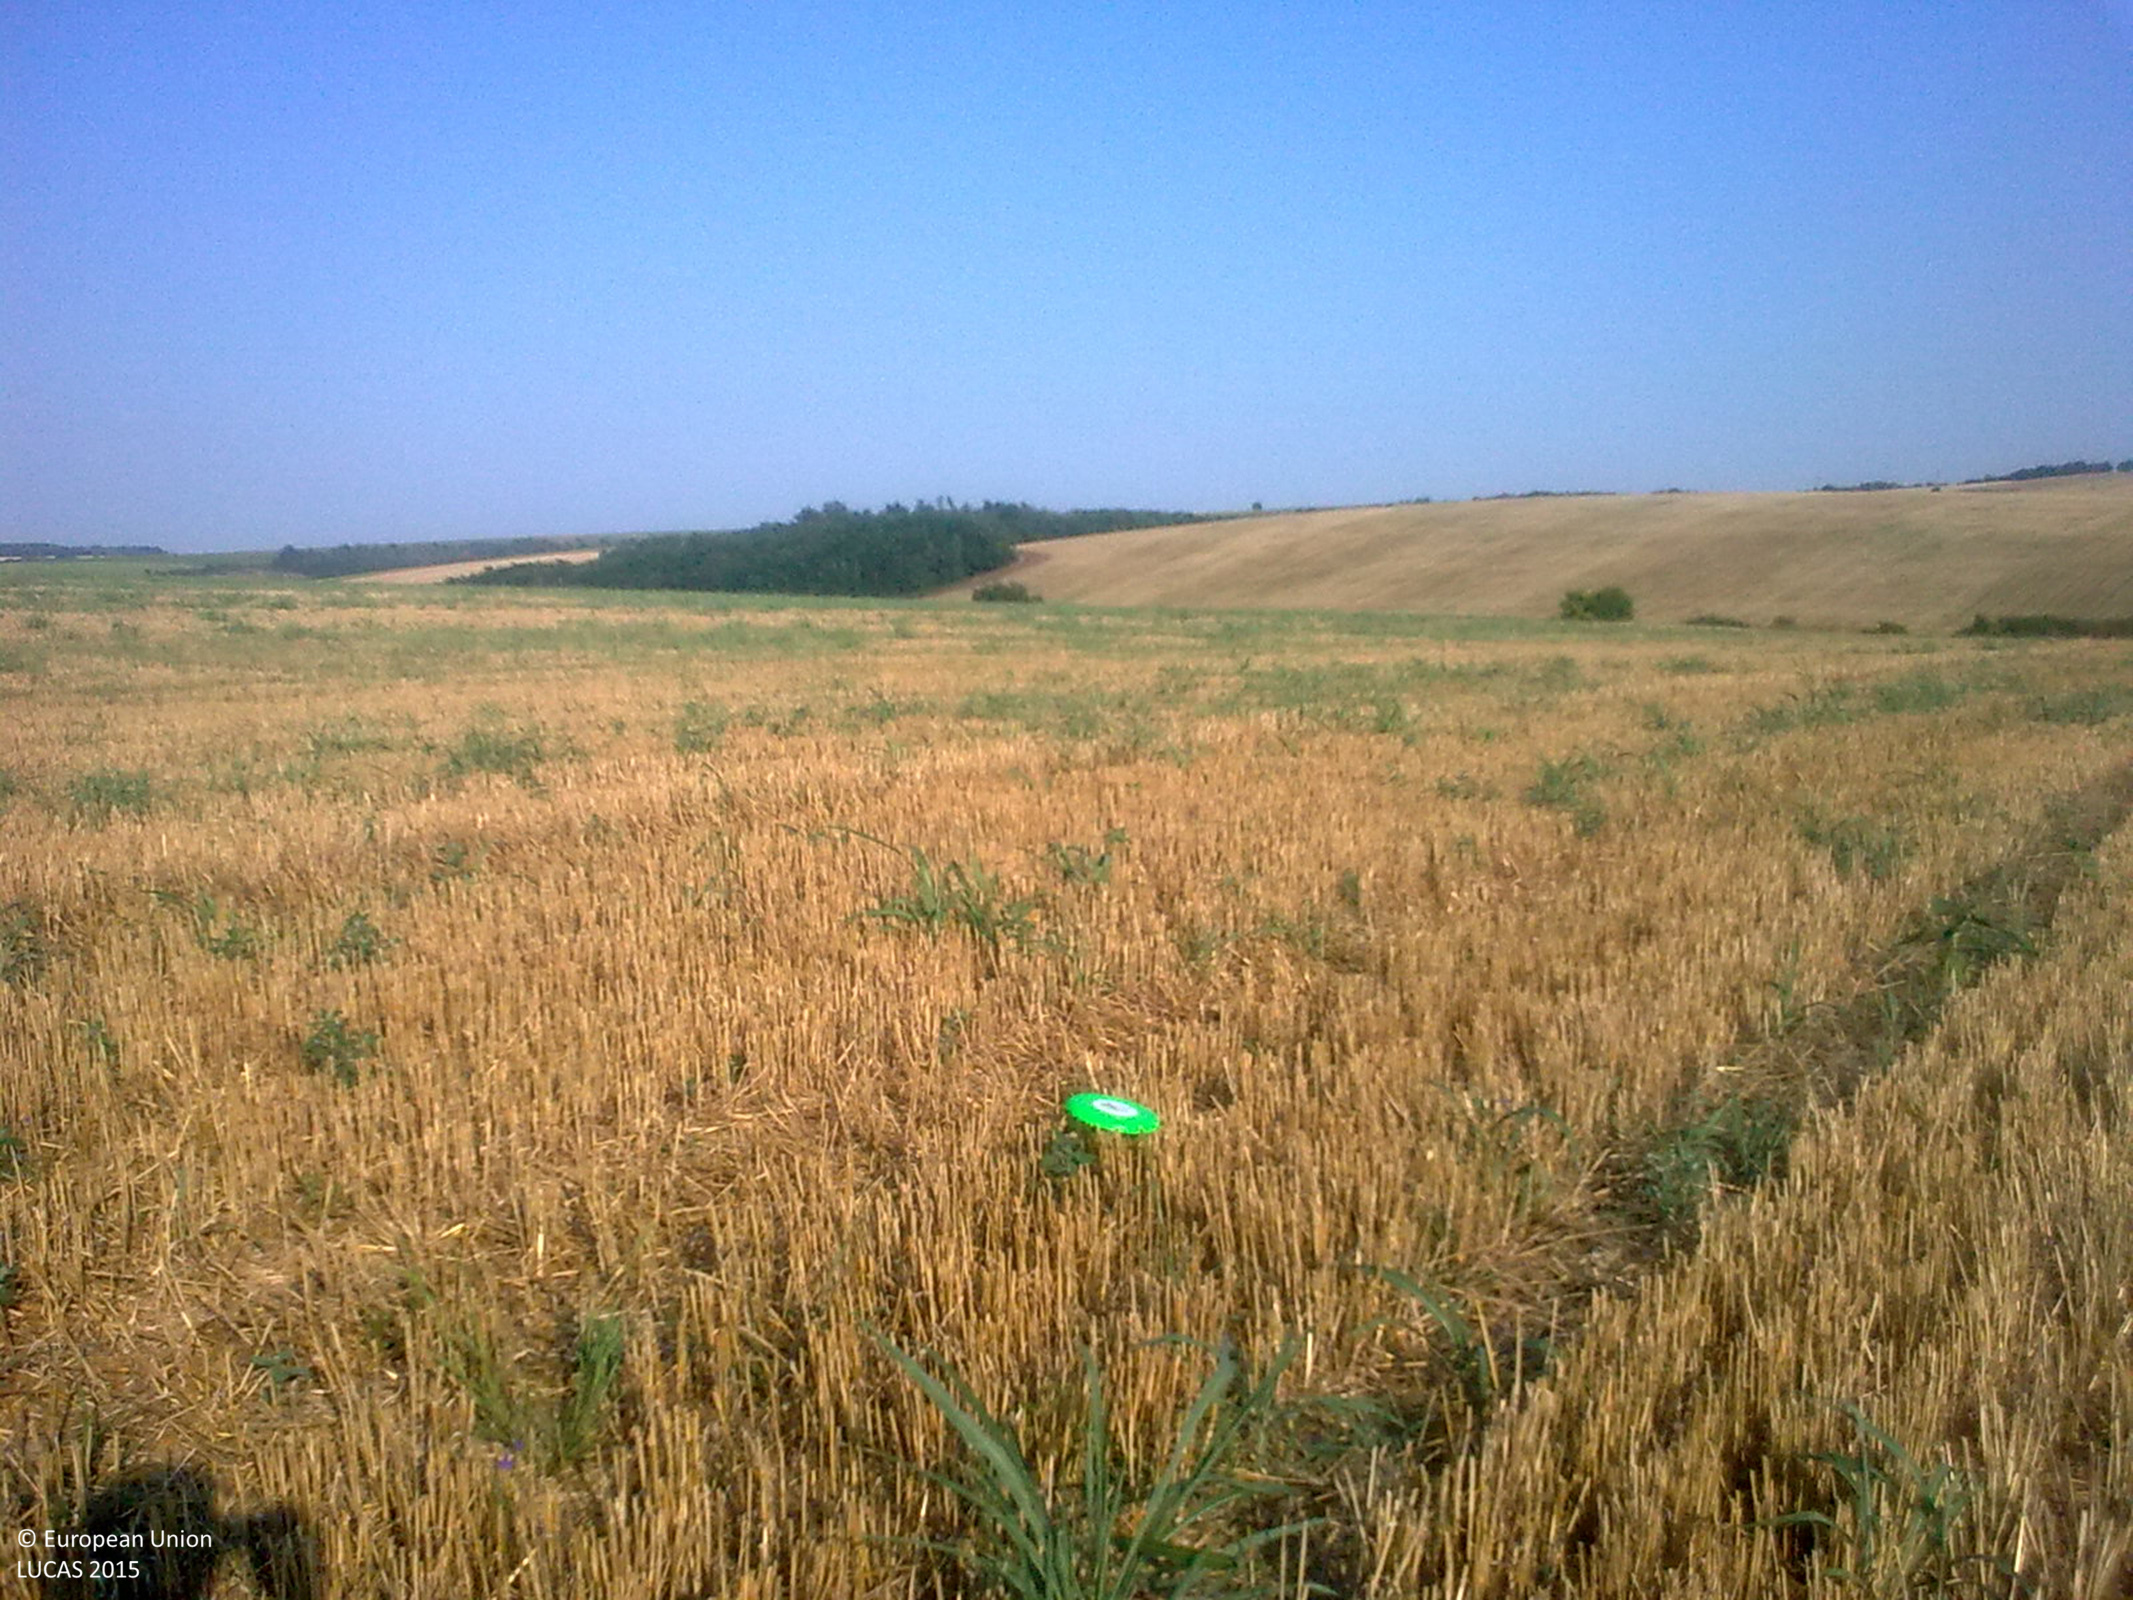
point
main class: Cropland
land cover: Common wheat
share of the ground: 50 - 75 %
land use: Agriculture (excluding fallow land and kitchen gardens)
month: July
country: BG
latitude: 43.8141
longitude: 26.1241
